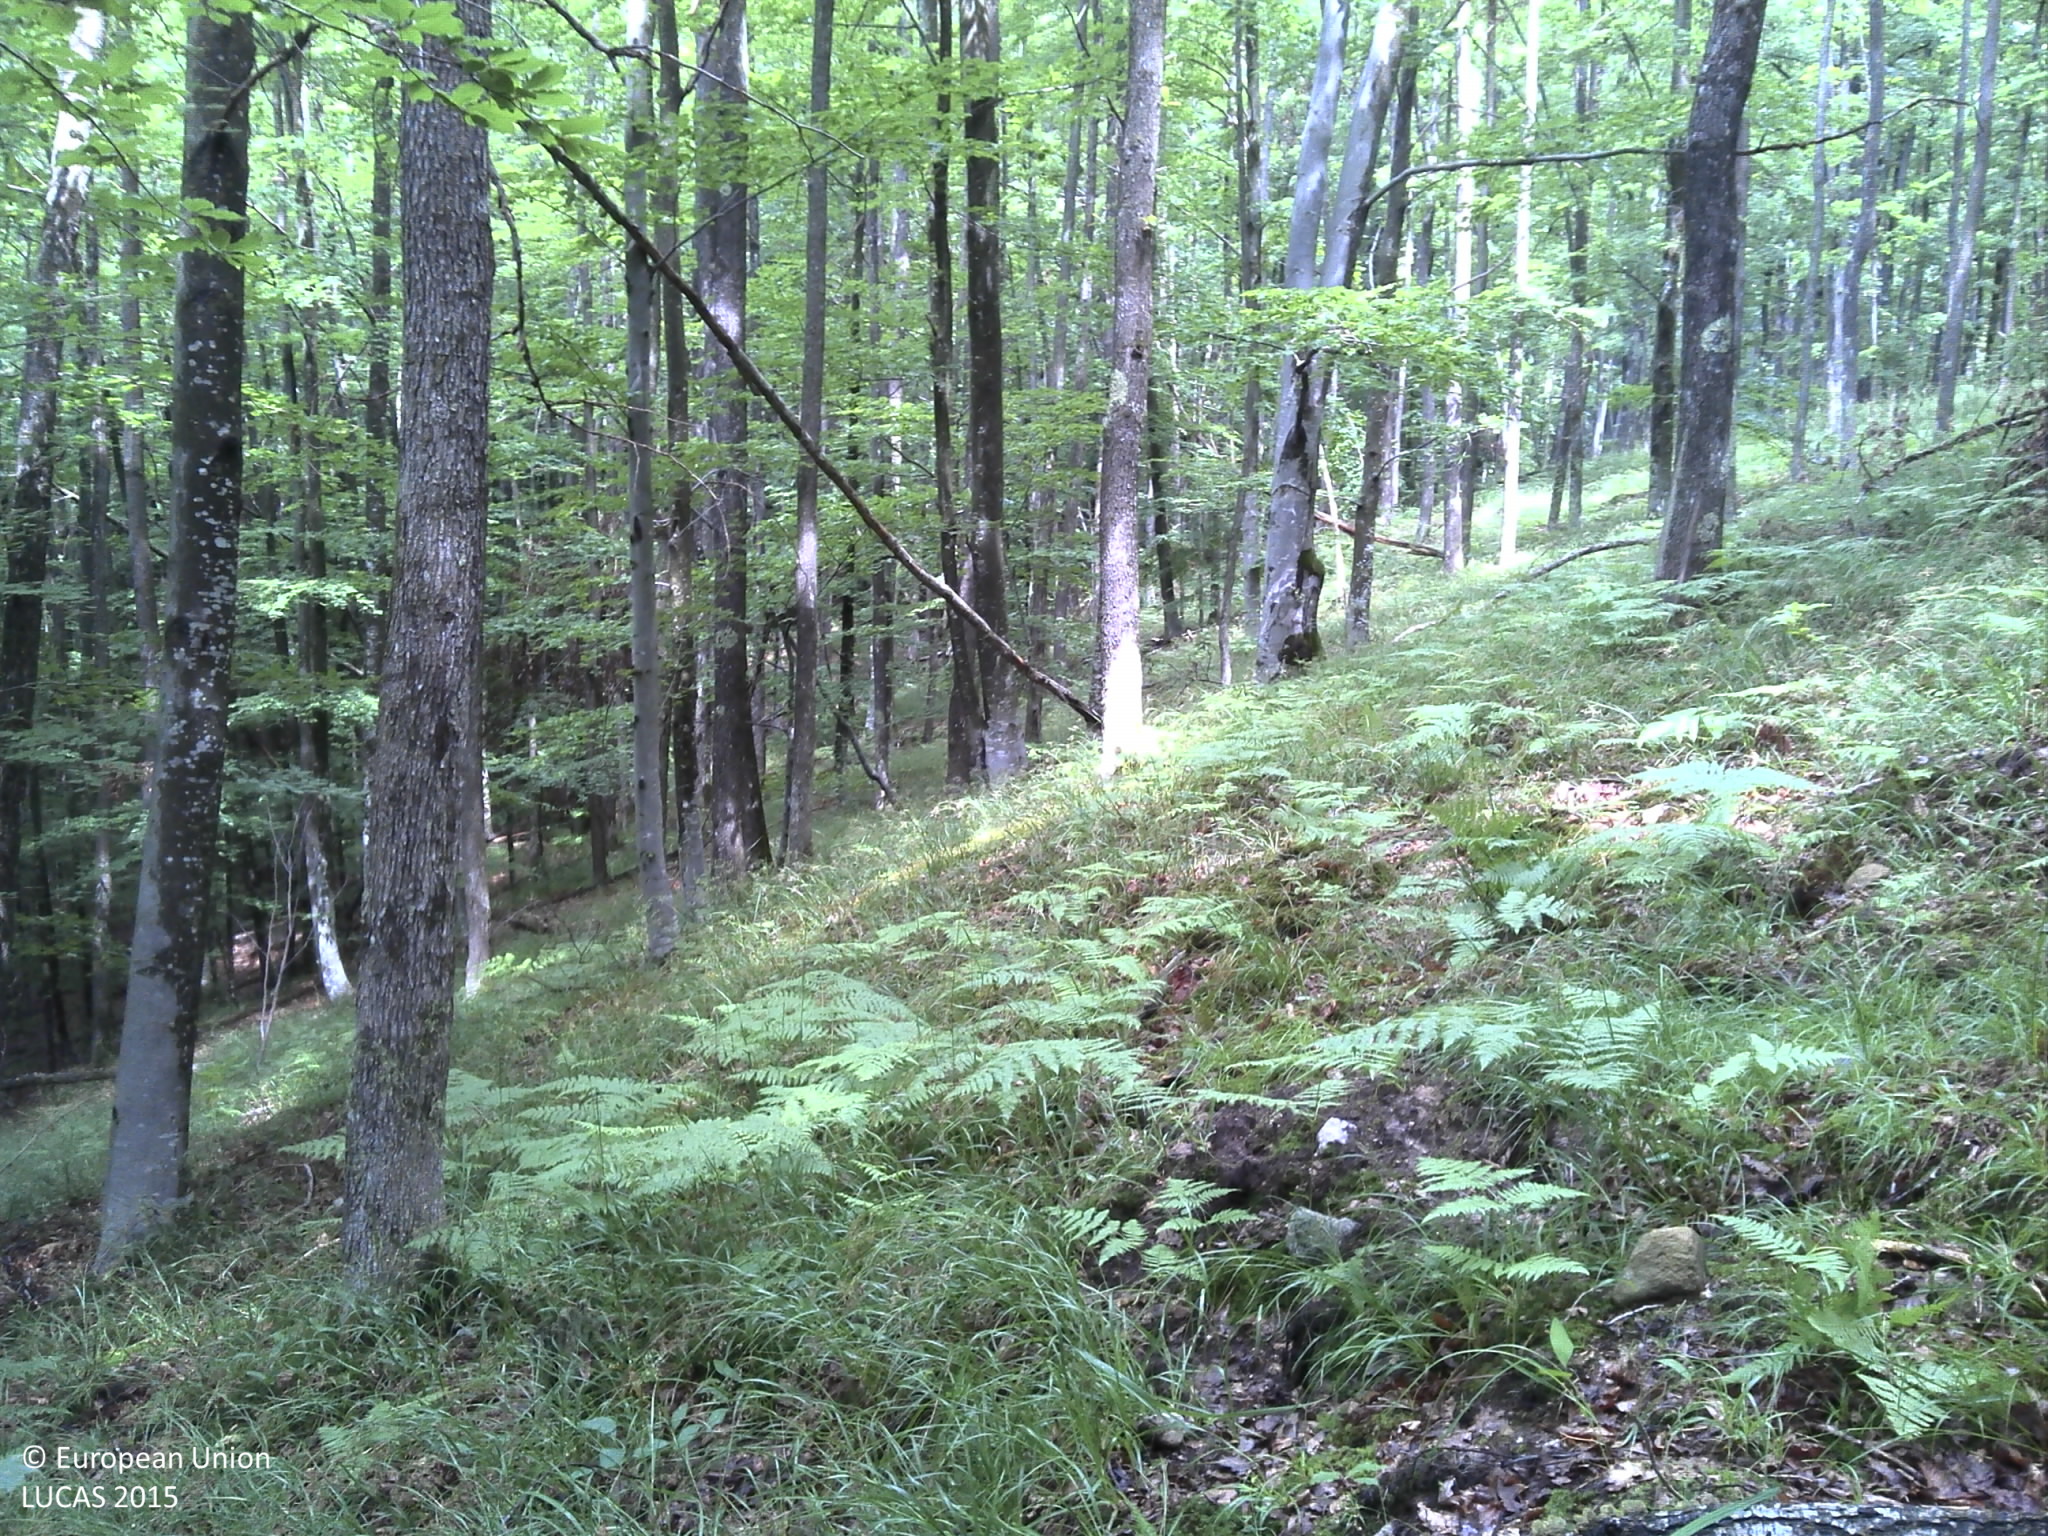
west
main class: Woodland
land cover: Broadleaved woodland
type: beech forest
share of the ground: > 75 %
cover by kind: broadleaved forest trees 80 %, lichens and mosses 20 %
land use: Forestry
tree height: > 5 m
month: June
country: HR
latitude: 45.5275
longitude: 17.4918
